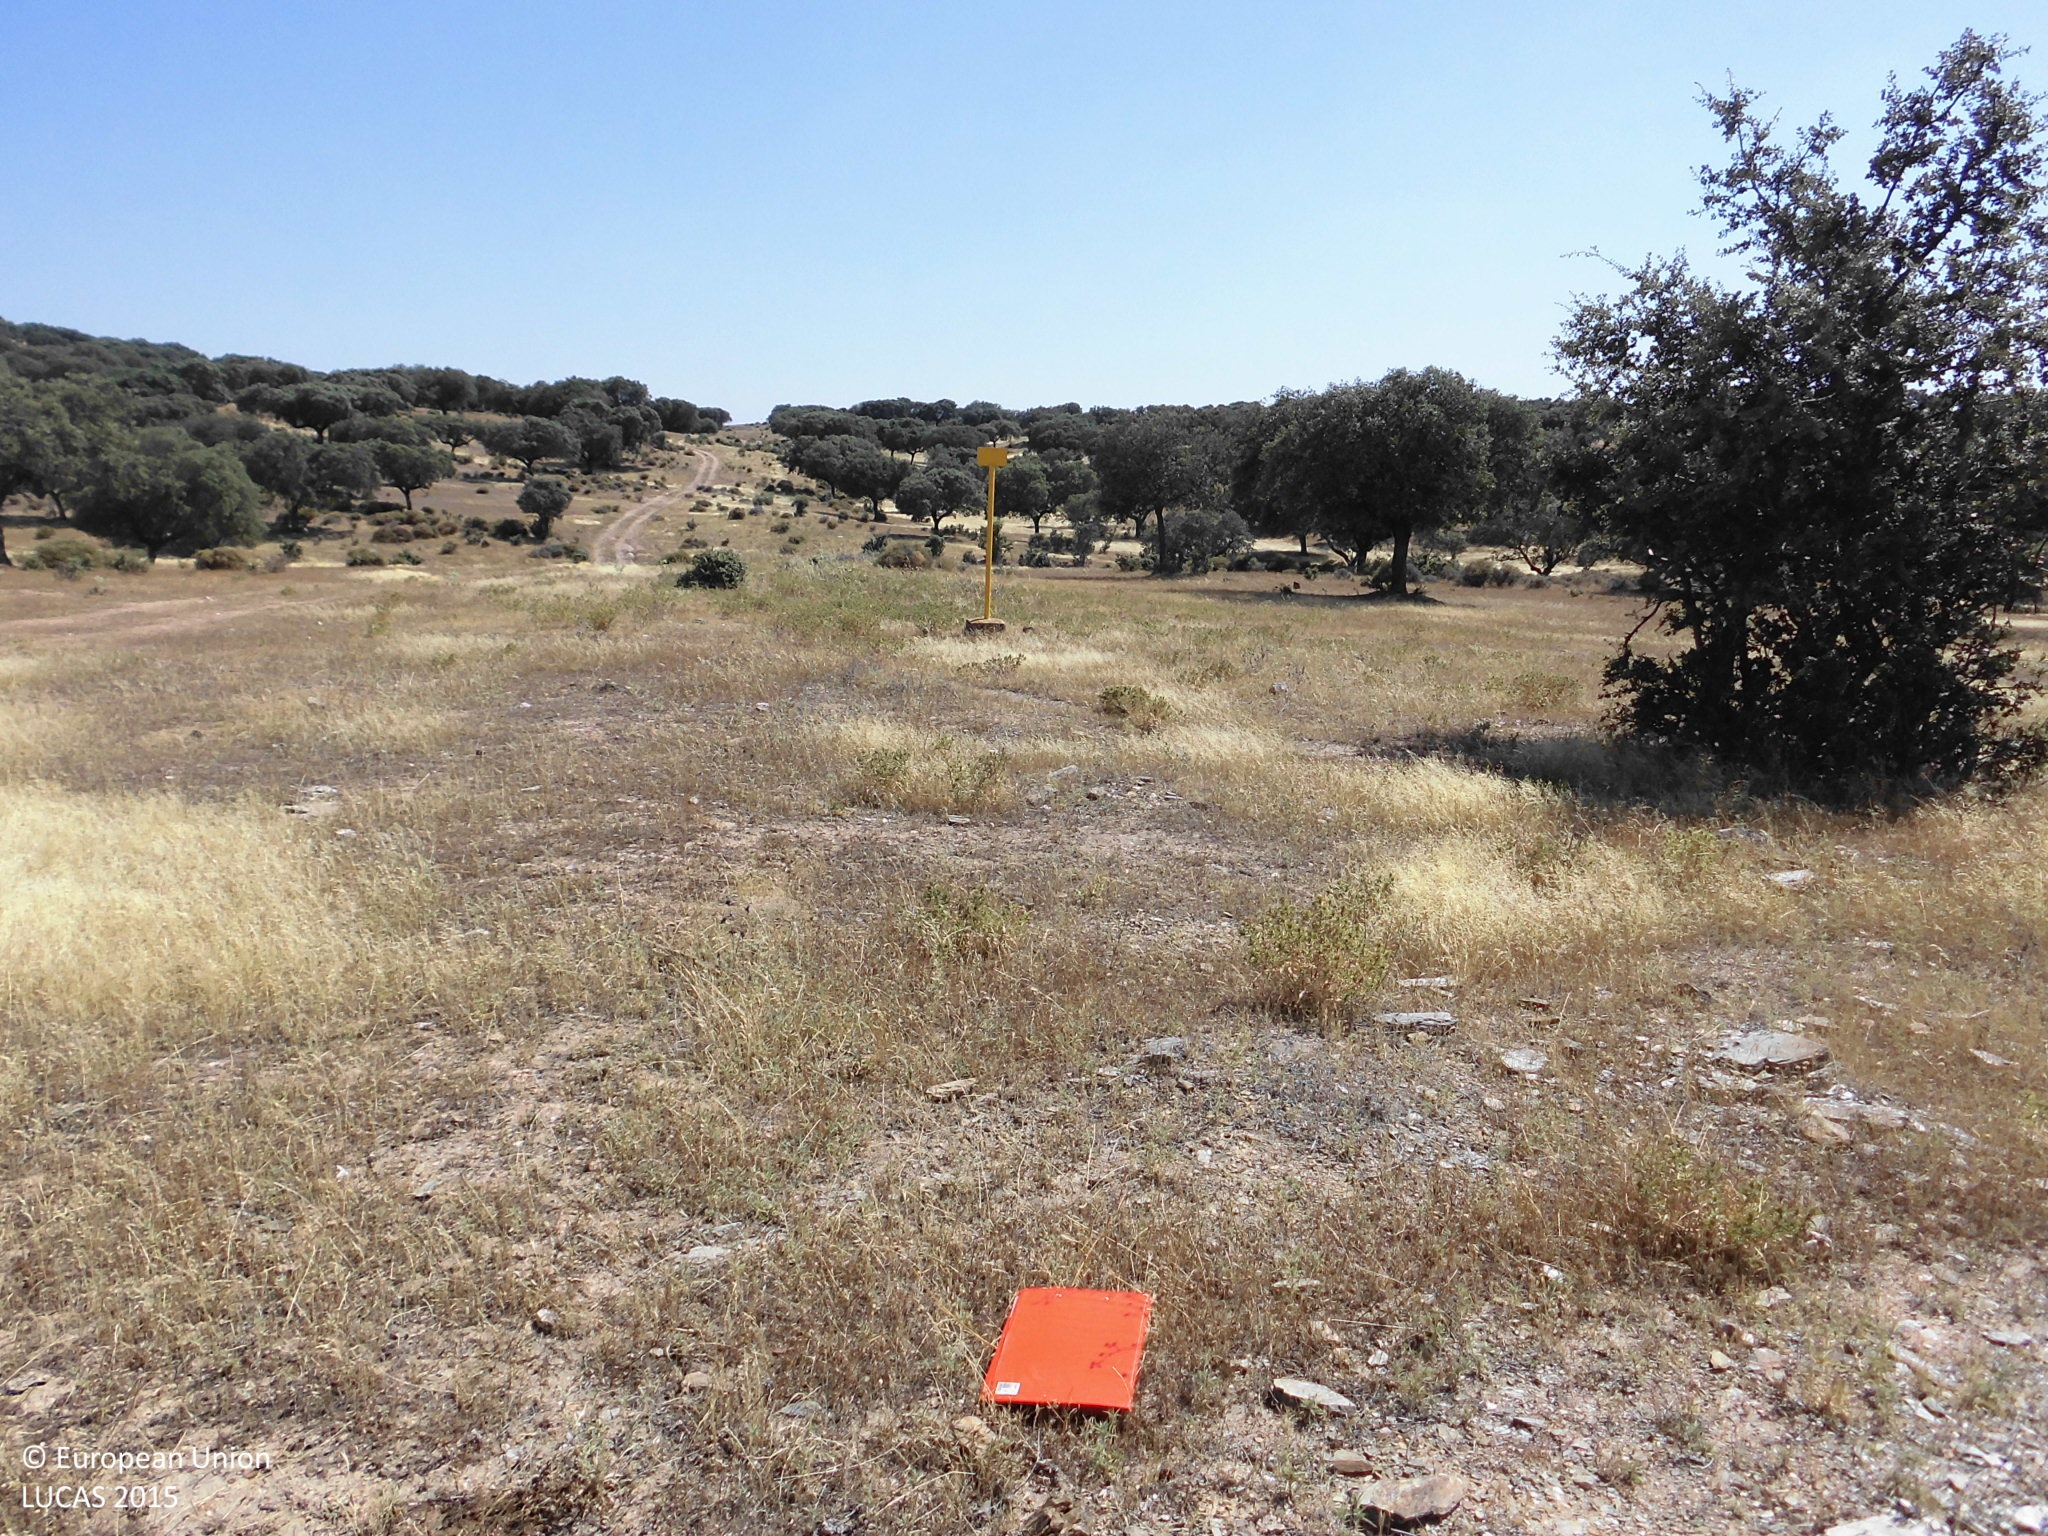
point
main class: Woodland
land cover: Broadleaved woodland
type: broadleaved evergreen forest
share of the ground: 10 - 25 %
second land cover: Grassland without tree/shrub cover
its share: > 75 %
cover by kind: herbaceous plants 90 %, broadleaved forest trees 10 %
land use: Forestry
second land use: Agriculture (excluding fallow land and kitchen gardens)
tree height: > 5 m
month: June
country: ES
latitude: 39.7496
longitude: -6.1386
